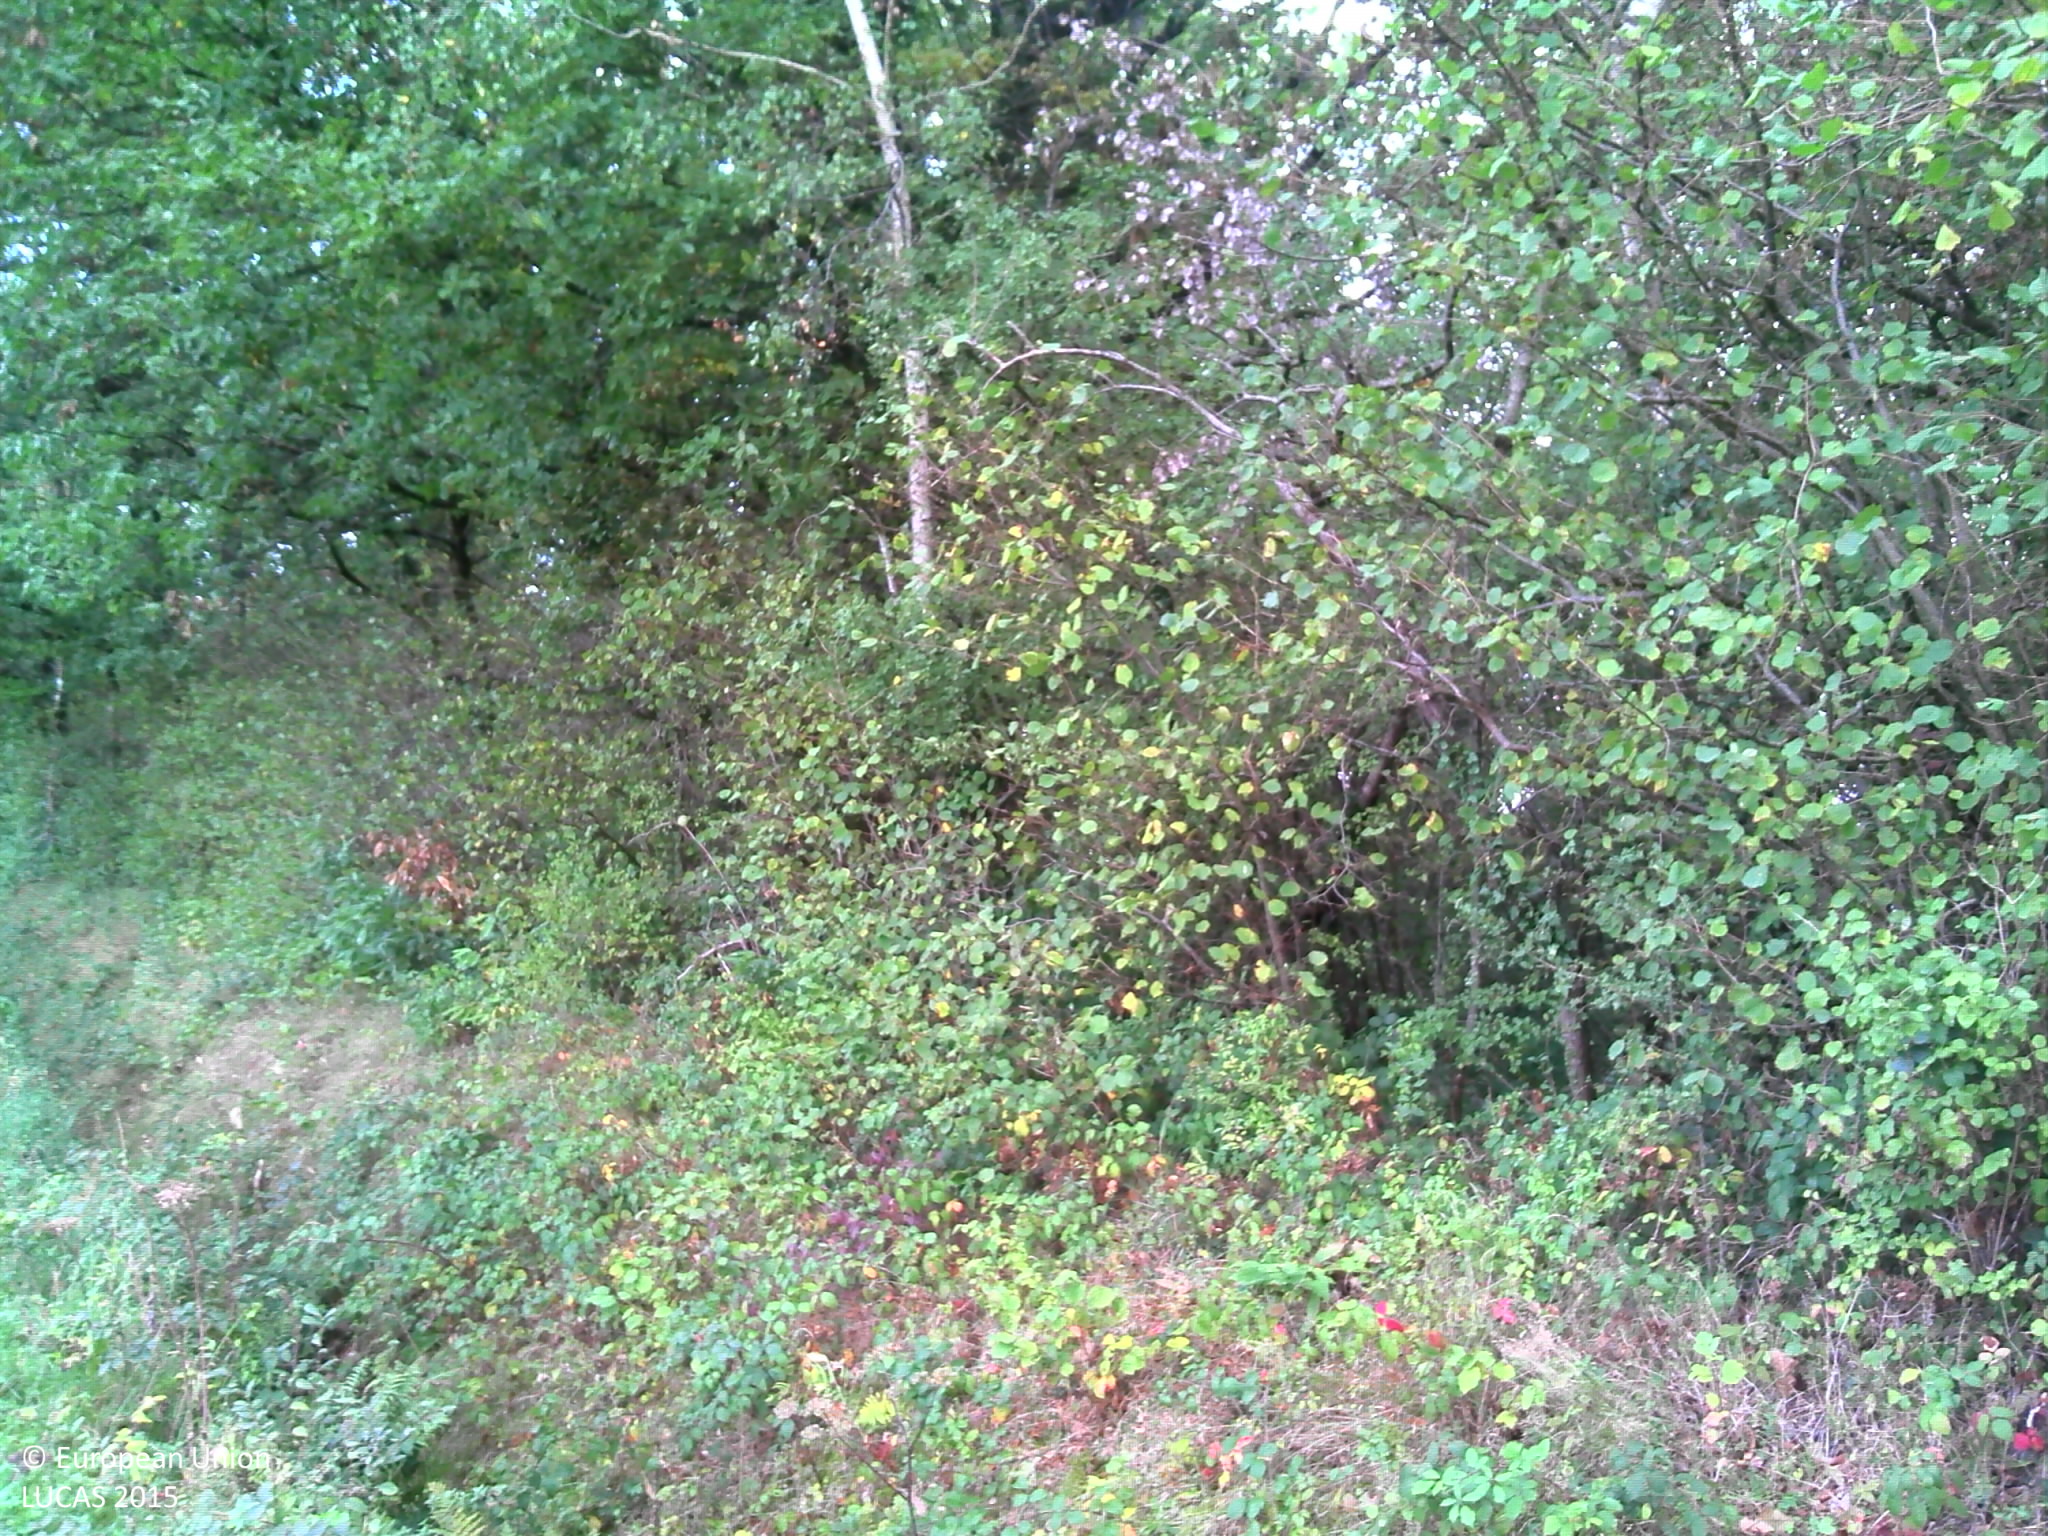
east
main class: Grassland
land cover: Grassland without tree/shrub cover
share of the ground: > 75 %
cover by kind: herbaceous plants 100 %
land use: Agriculture (excluding fallow land and kitchen gardens)
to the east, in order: Grassland without tree/shrub cover; Ditches and canals; Broadleaved woodland; Ditches and canals; Sunflower; Ditches and canals; Grass margins; Tracks; Maize
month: October
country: FR
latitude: 45.8730
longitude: 4.9920
